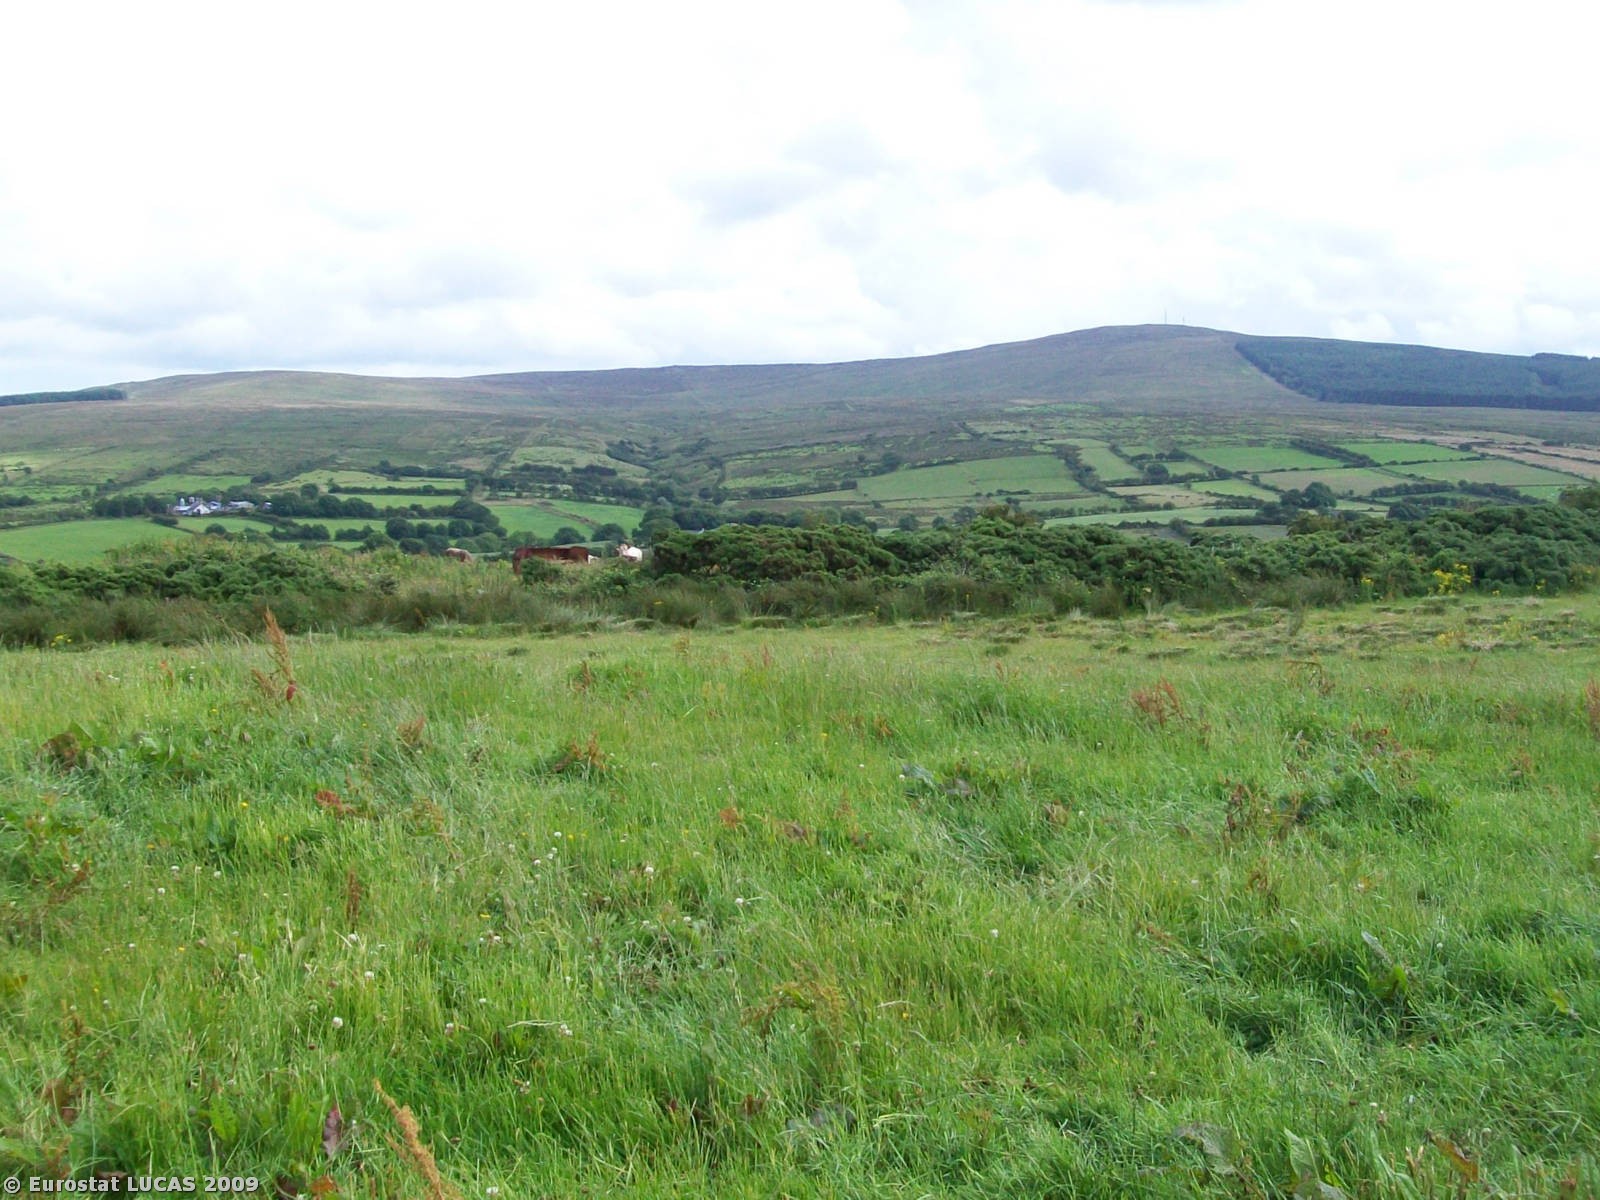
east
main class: Grassland
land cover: Grassland without tree/shrub cover
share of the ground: > 75 %
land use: Agriculture (excluding fallow land and kitchen gardens)
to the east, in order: Grassland without tree/shrub cover; Abandoned hedges; Grassland without tree/shrub cover; Fences; Dry stone walls; Abandoned hedges; Grassland without tree/shrub cover; Fences; Abandoned hedges; Fences; Grassland without tree/shrub cover
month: July
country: GB
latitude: 55.0799
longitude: -6.2975
